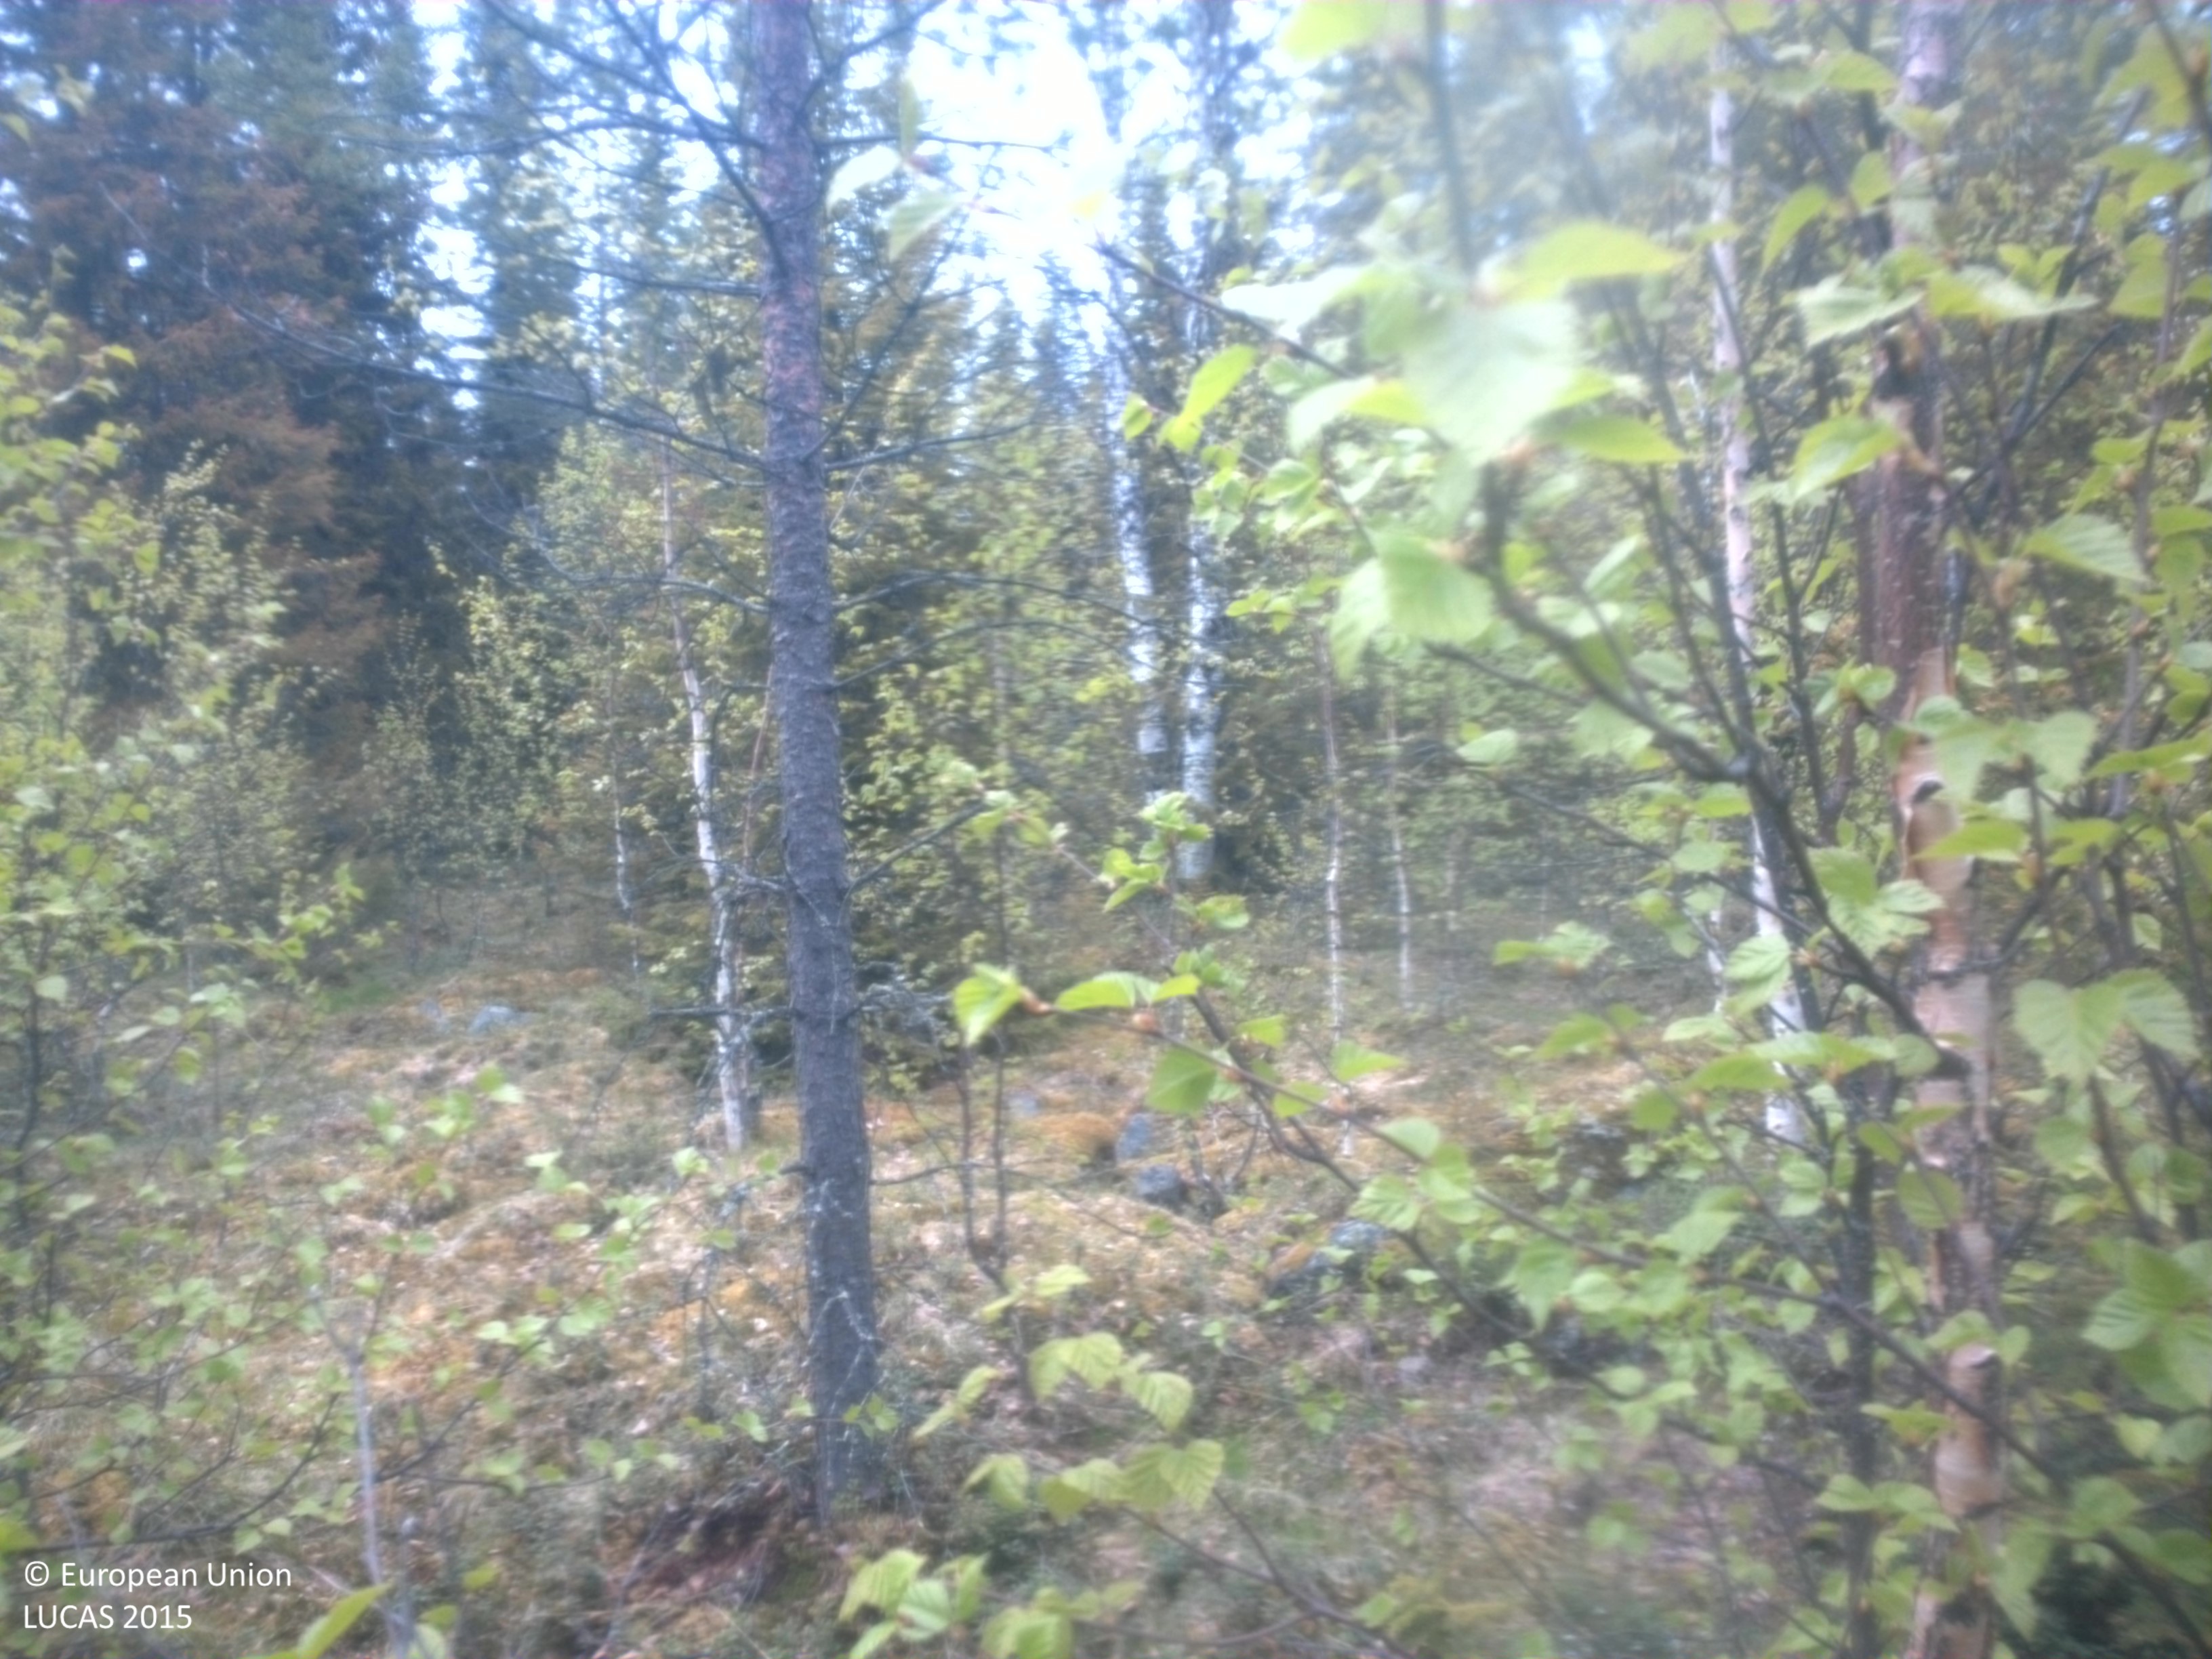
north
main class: Woodland
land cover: Broadleaved woodland
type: boreal forest
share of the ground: 25 - 50 %
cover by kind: broadleaved forest trees 35 %, herbaceous plants 35 %, lichens and mosses 15 %, unconsolidated bare surface 10 %, coniferous forest trees 5 %
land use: Forestry
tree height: < 5 m
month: June
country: SE
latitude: 64.3906
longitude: 17.7440
